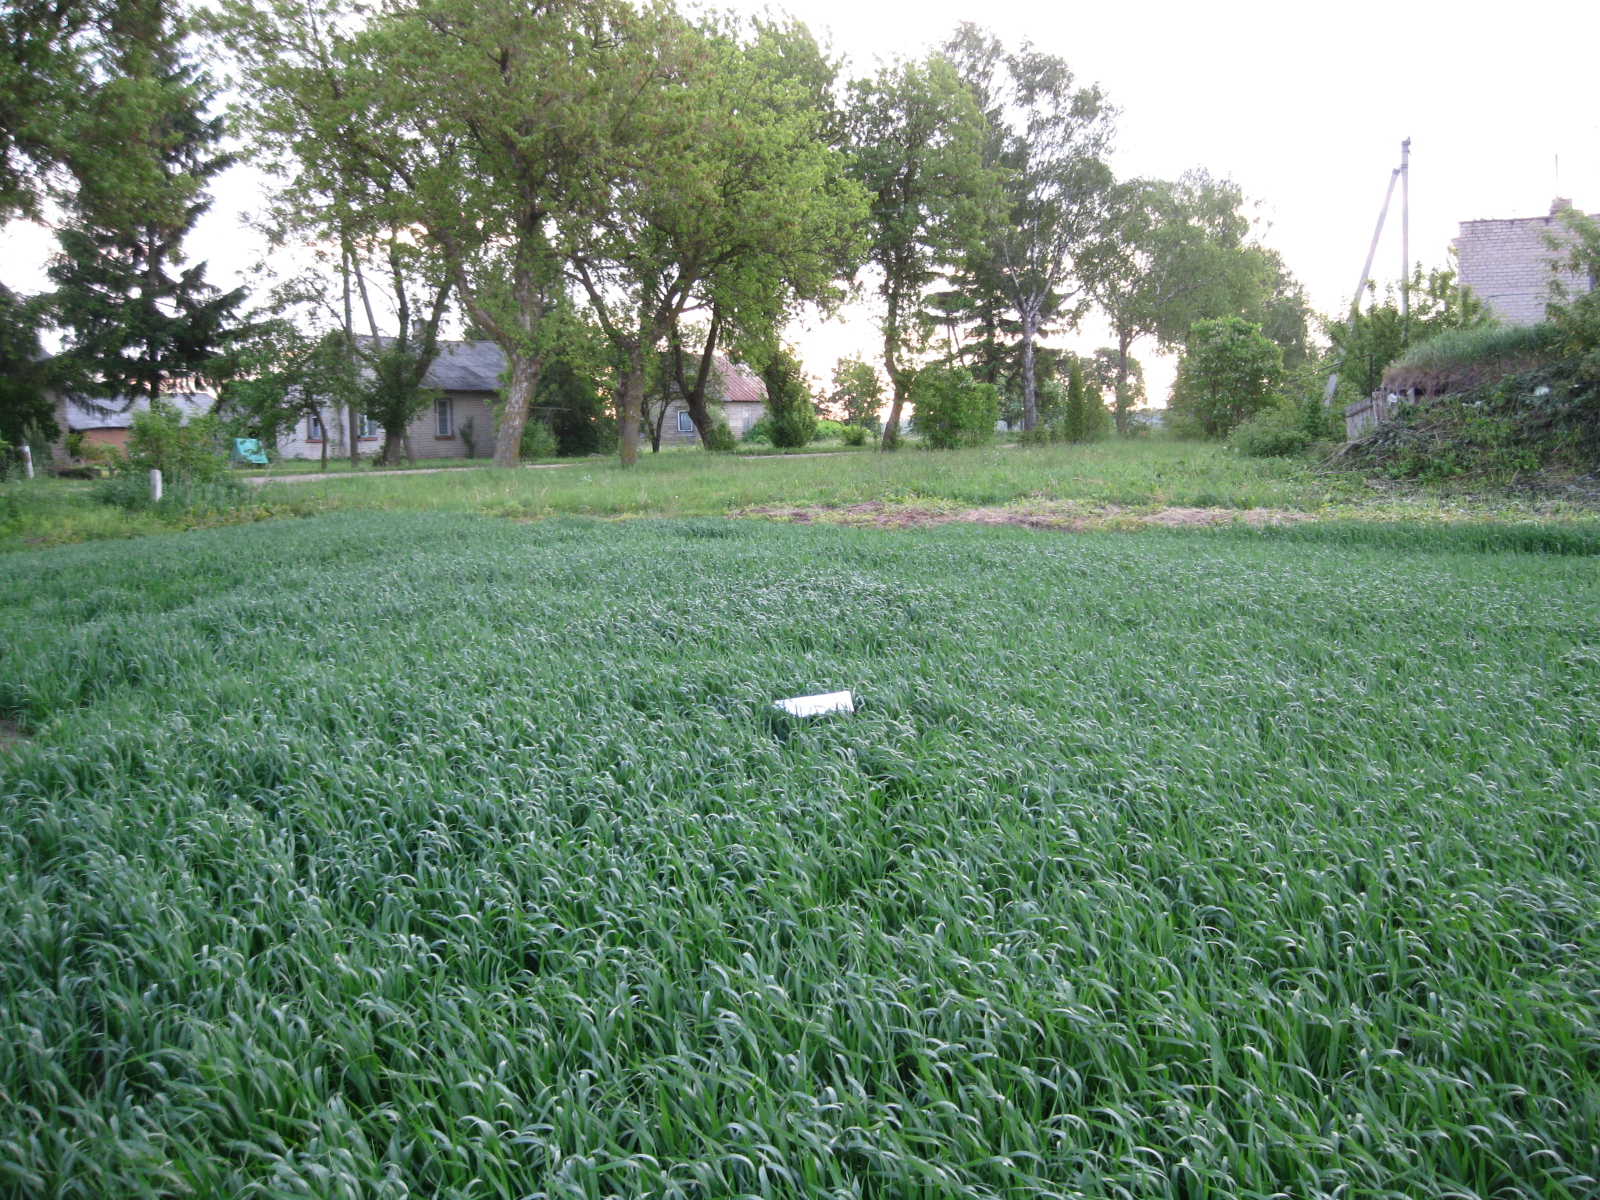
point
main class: Cropland
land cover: Common wheat
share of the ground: > 75 %
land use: Agriculture (excluding fallow land and kitchen gardens)
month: June
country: LT
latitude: 55.7236
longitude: 24.0197
